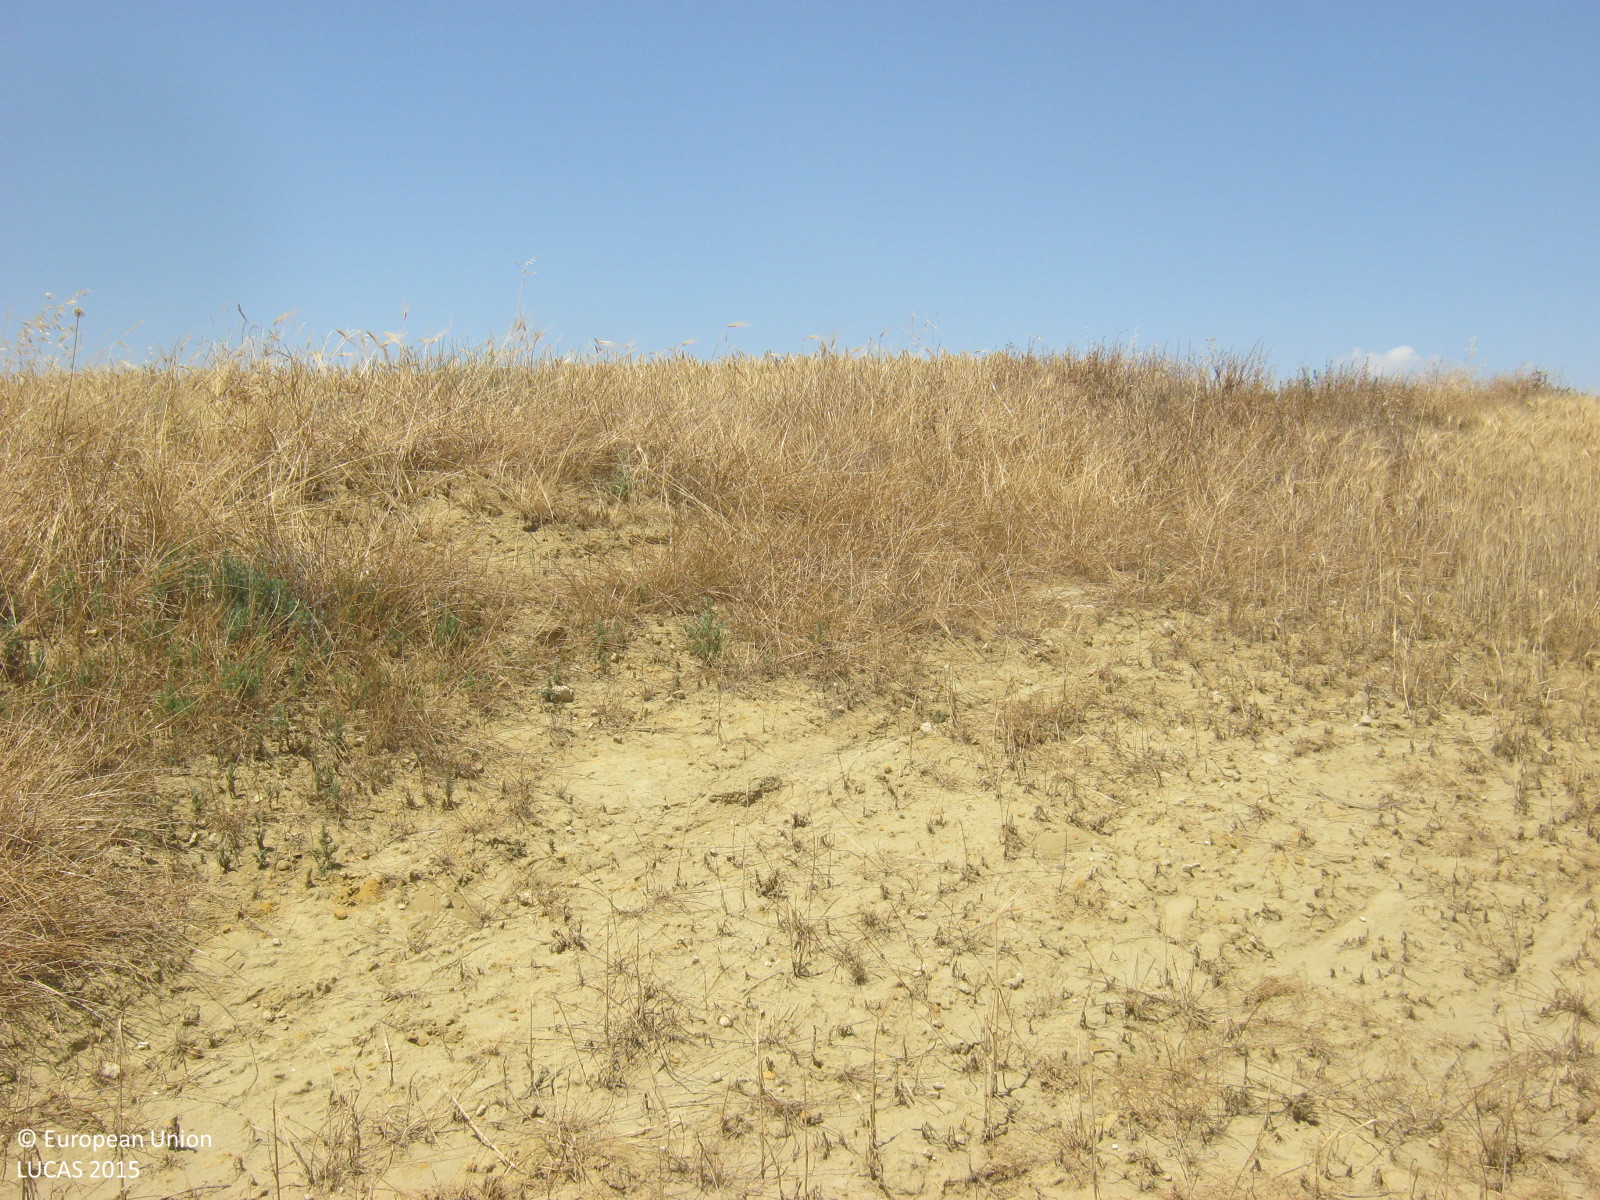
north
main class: Cropland
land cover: Common wheat
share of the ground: > 75 %
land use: Agriculture (excluding fallow land and kitchen gardens)
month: May
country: CY
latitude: 35.0834
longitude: 33.1150
